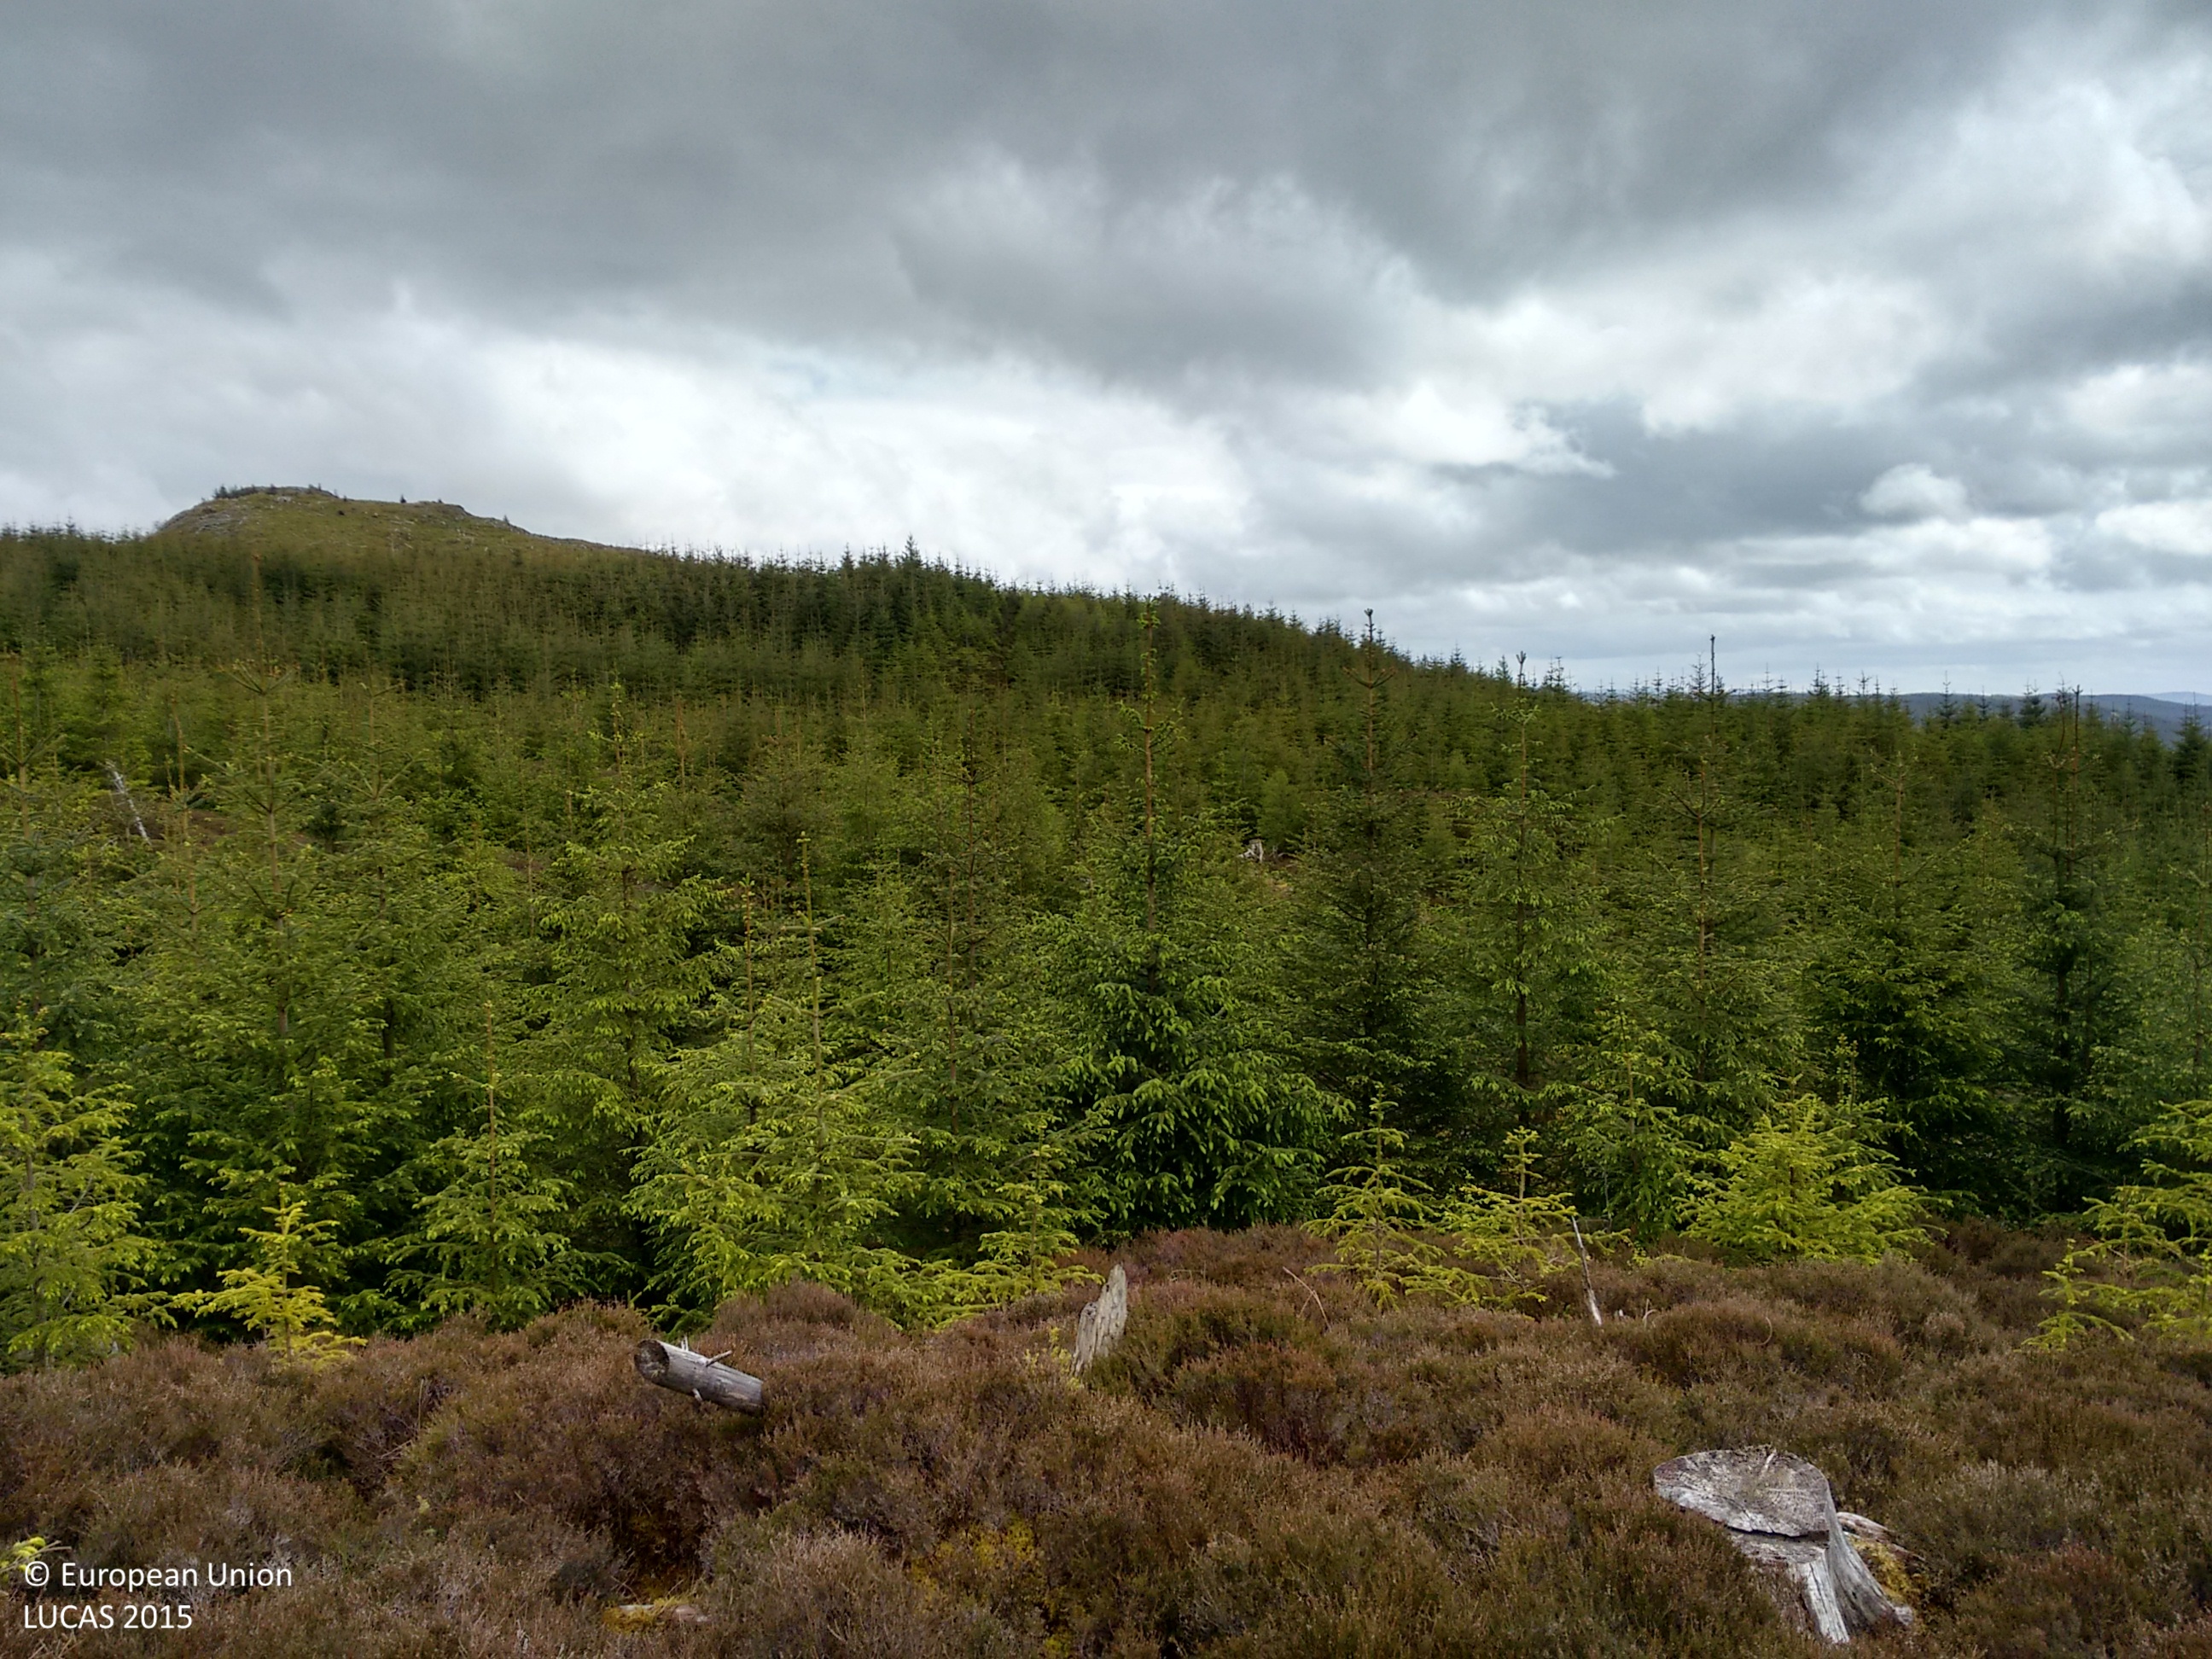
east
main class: Woodland
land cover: Spruce dominated coniferous woodland
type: exotic forest
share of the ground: > 75 %
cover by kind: coniferous forest trees 100 %
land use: Forestry
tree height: > 5 m
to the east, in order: Spruce dominated coniferous woodland; Rock outcrops; Spruce dominated coniferous woodland; Rock outcrops; Spruce dominated coniferous woodland; Shrubland with sparse tree cover; Spruce dominated coniferous woodland
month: June
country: GB
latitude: 56.1205
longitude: -5.4825
